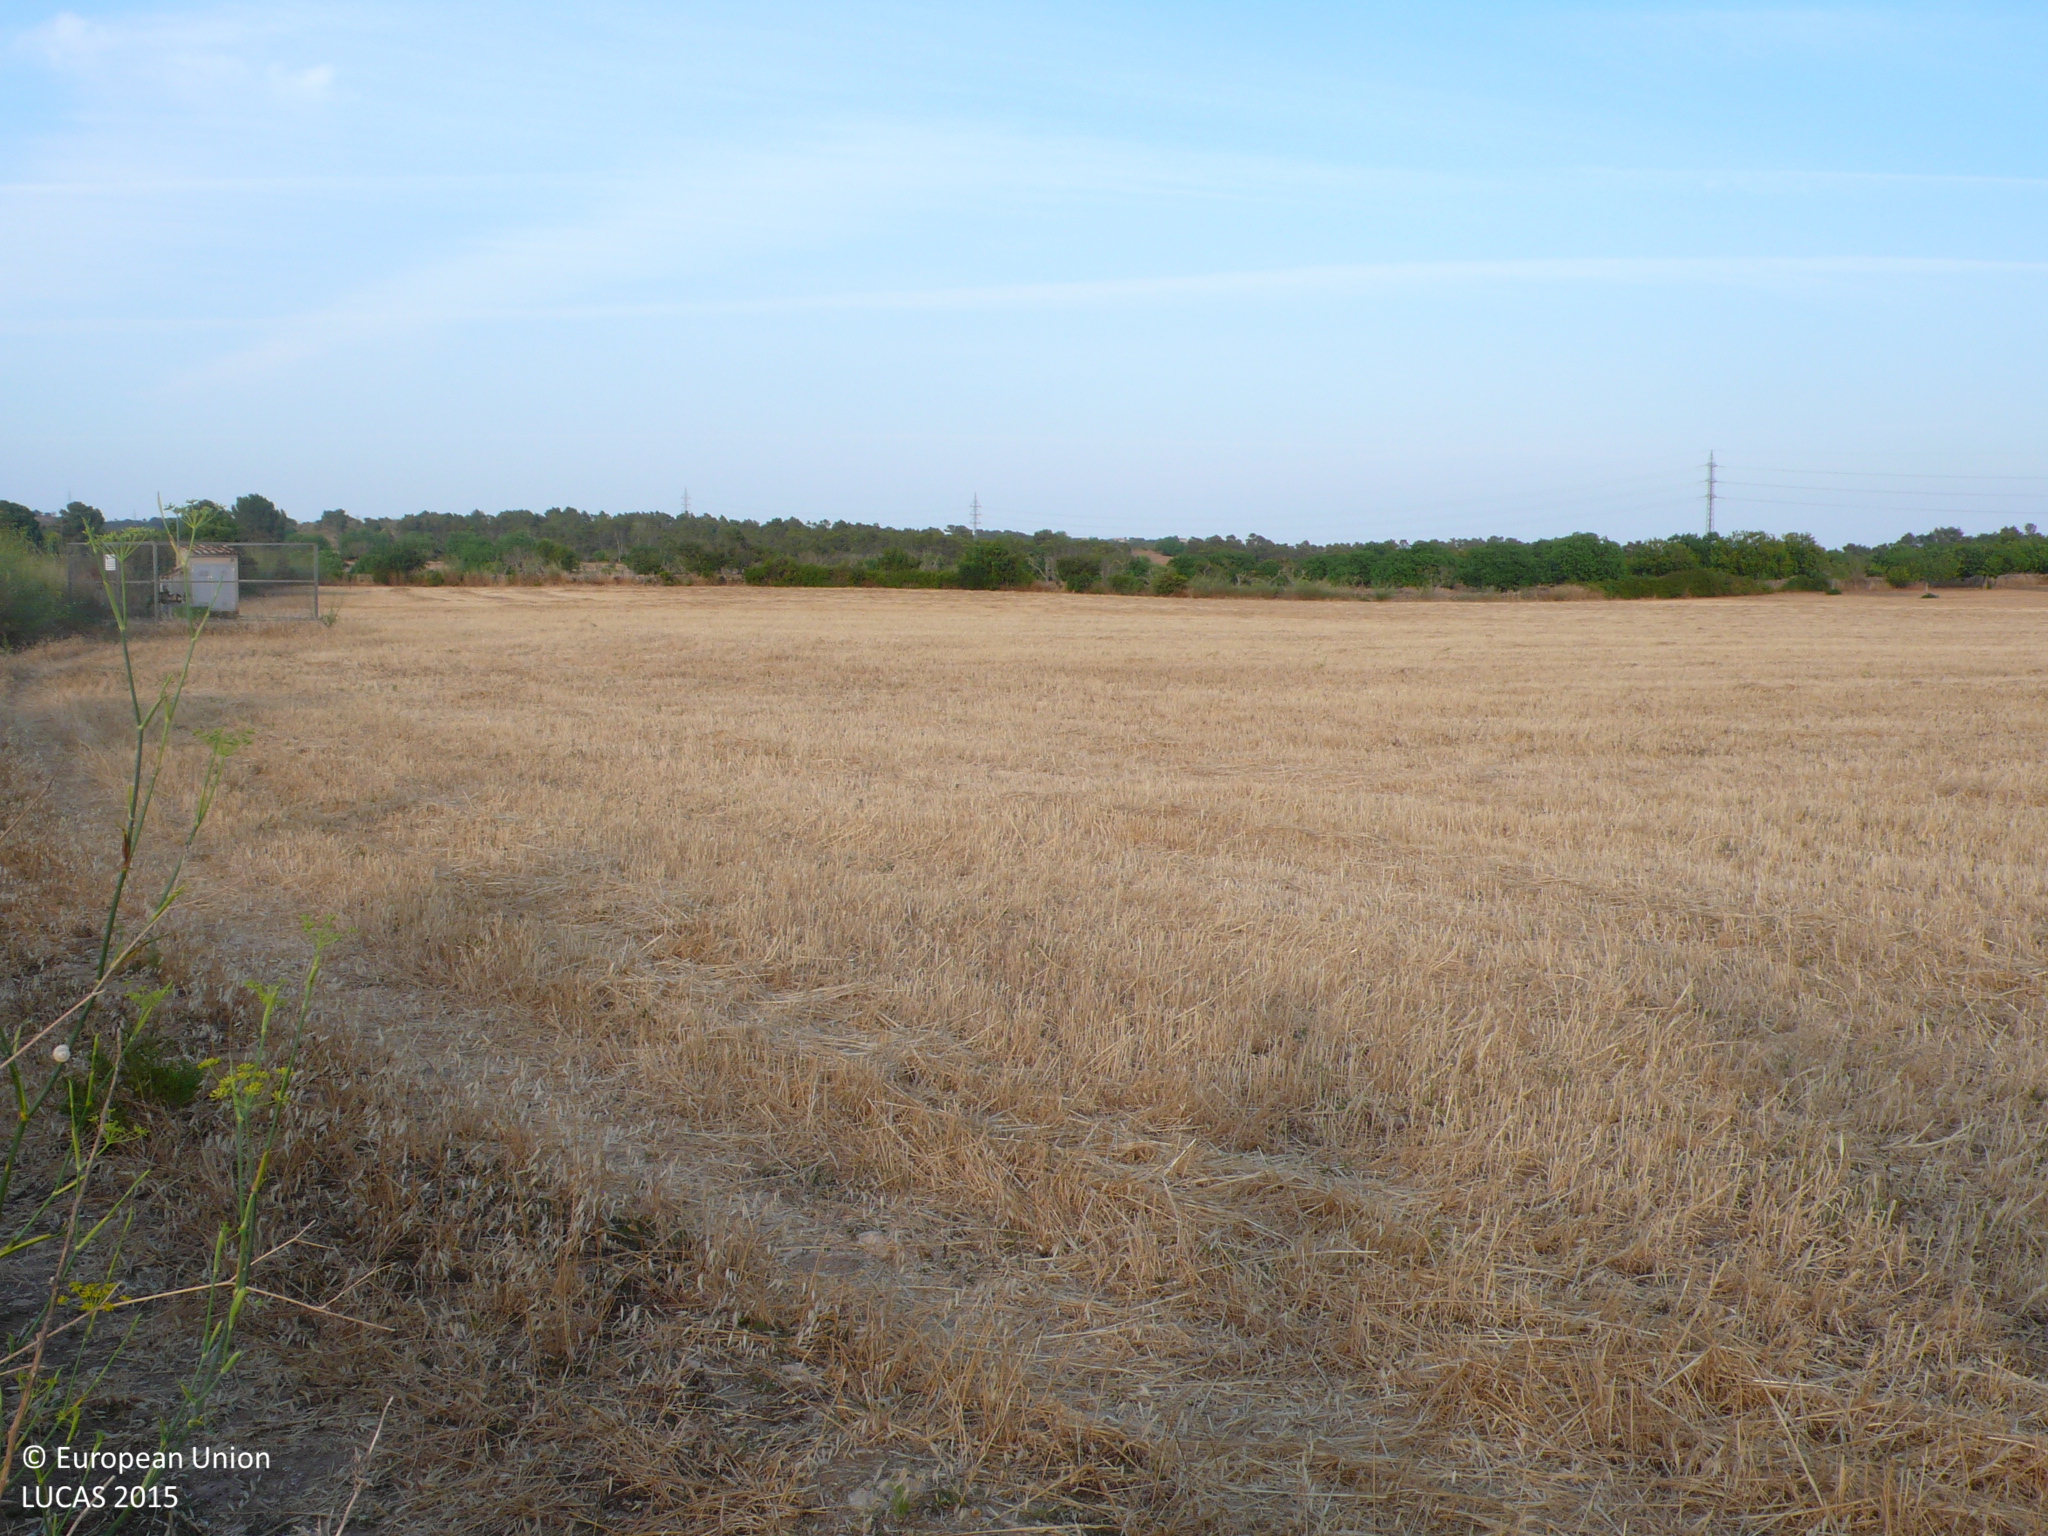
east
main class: Cropland
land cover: Mixed cereals for fodder
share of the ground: > 75 %
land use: Agriculture (excluding fallow land and kitchen gardens)
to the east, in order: Mixed cereals for fodder; Electric lines; Mixed cereals for fodder; Dry stone walls; Shruby margins; Barley; Dry stone walls; Spontaneously vegetated surfaces
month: July
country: ES
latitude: 39.5637
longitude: 3.2673
